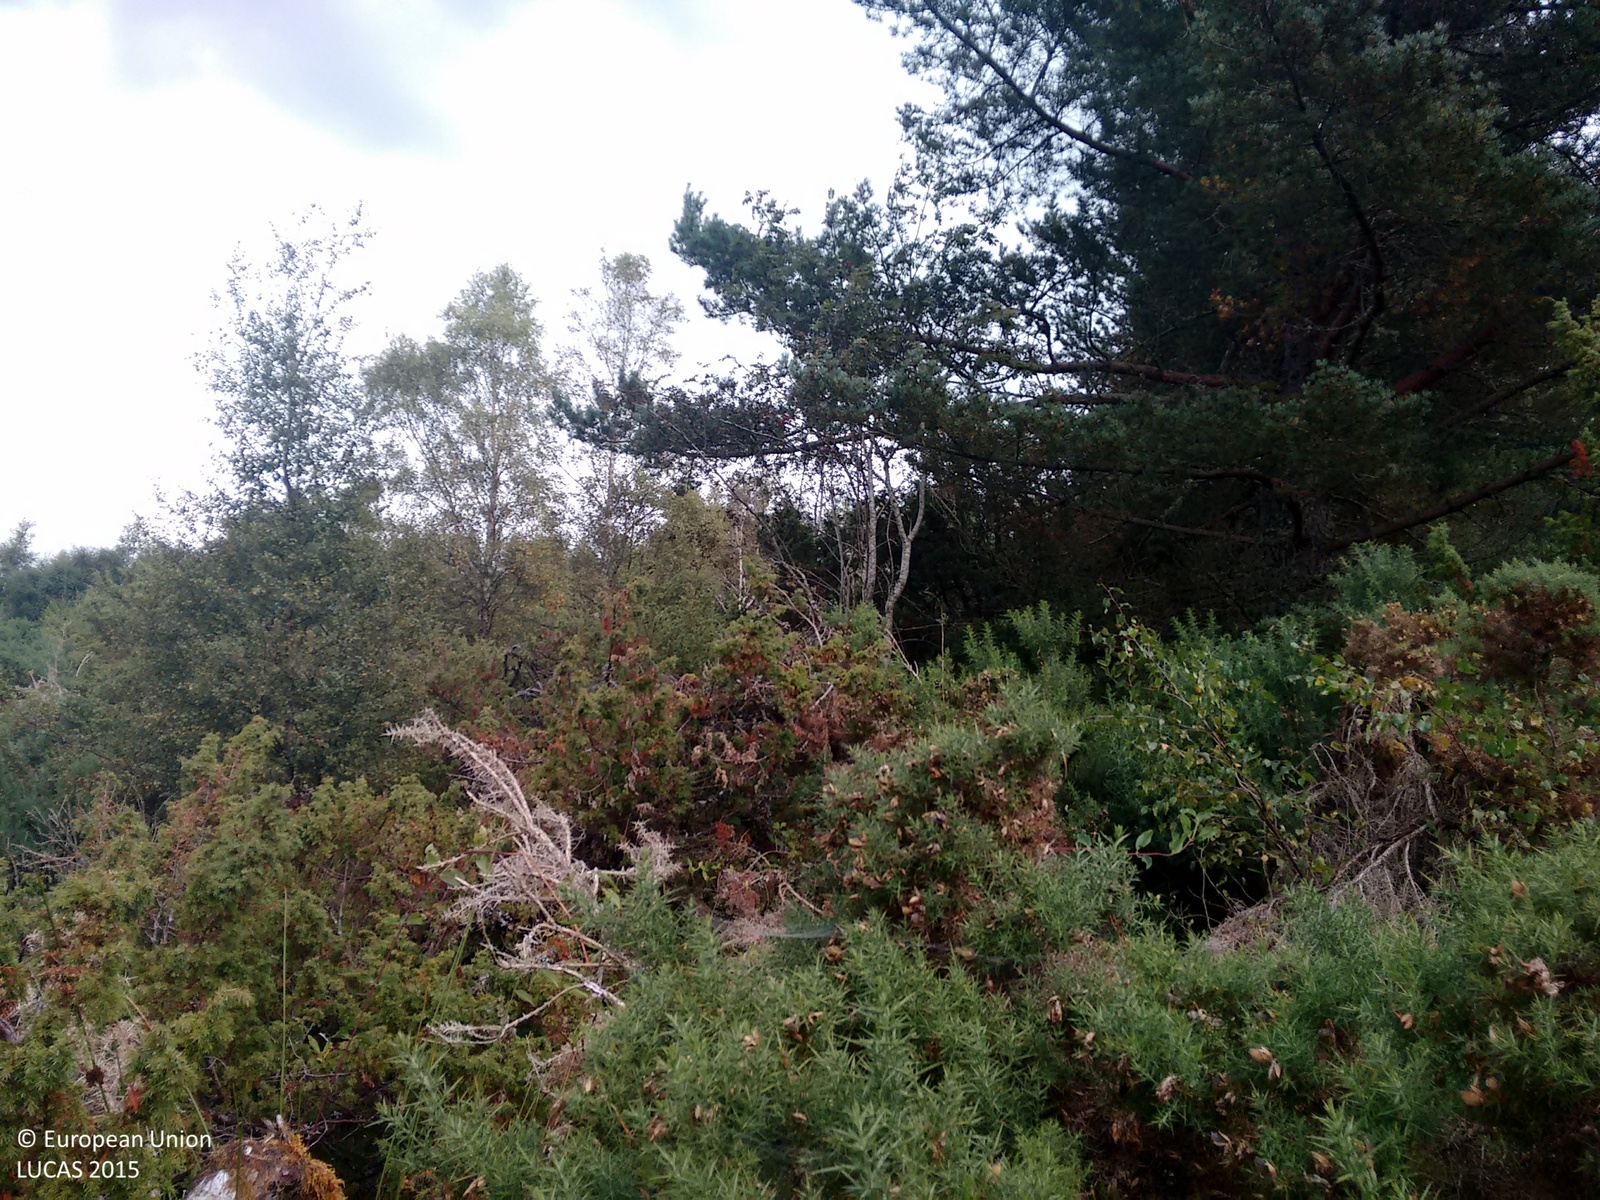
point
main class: Woodland
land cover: Other mixed woodland
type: exotic forest
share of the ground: > 75 %
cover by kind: coniferous forest trees 45 %, broadleaved forest trees 30 %, shrubs 25 %
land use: Agriculture (excluding fallow land and kitchen gardens)
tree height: > 5 m
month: September
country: GB
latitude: 57.4135
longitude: -4.4576
